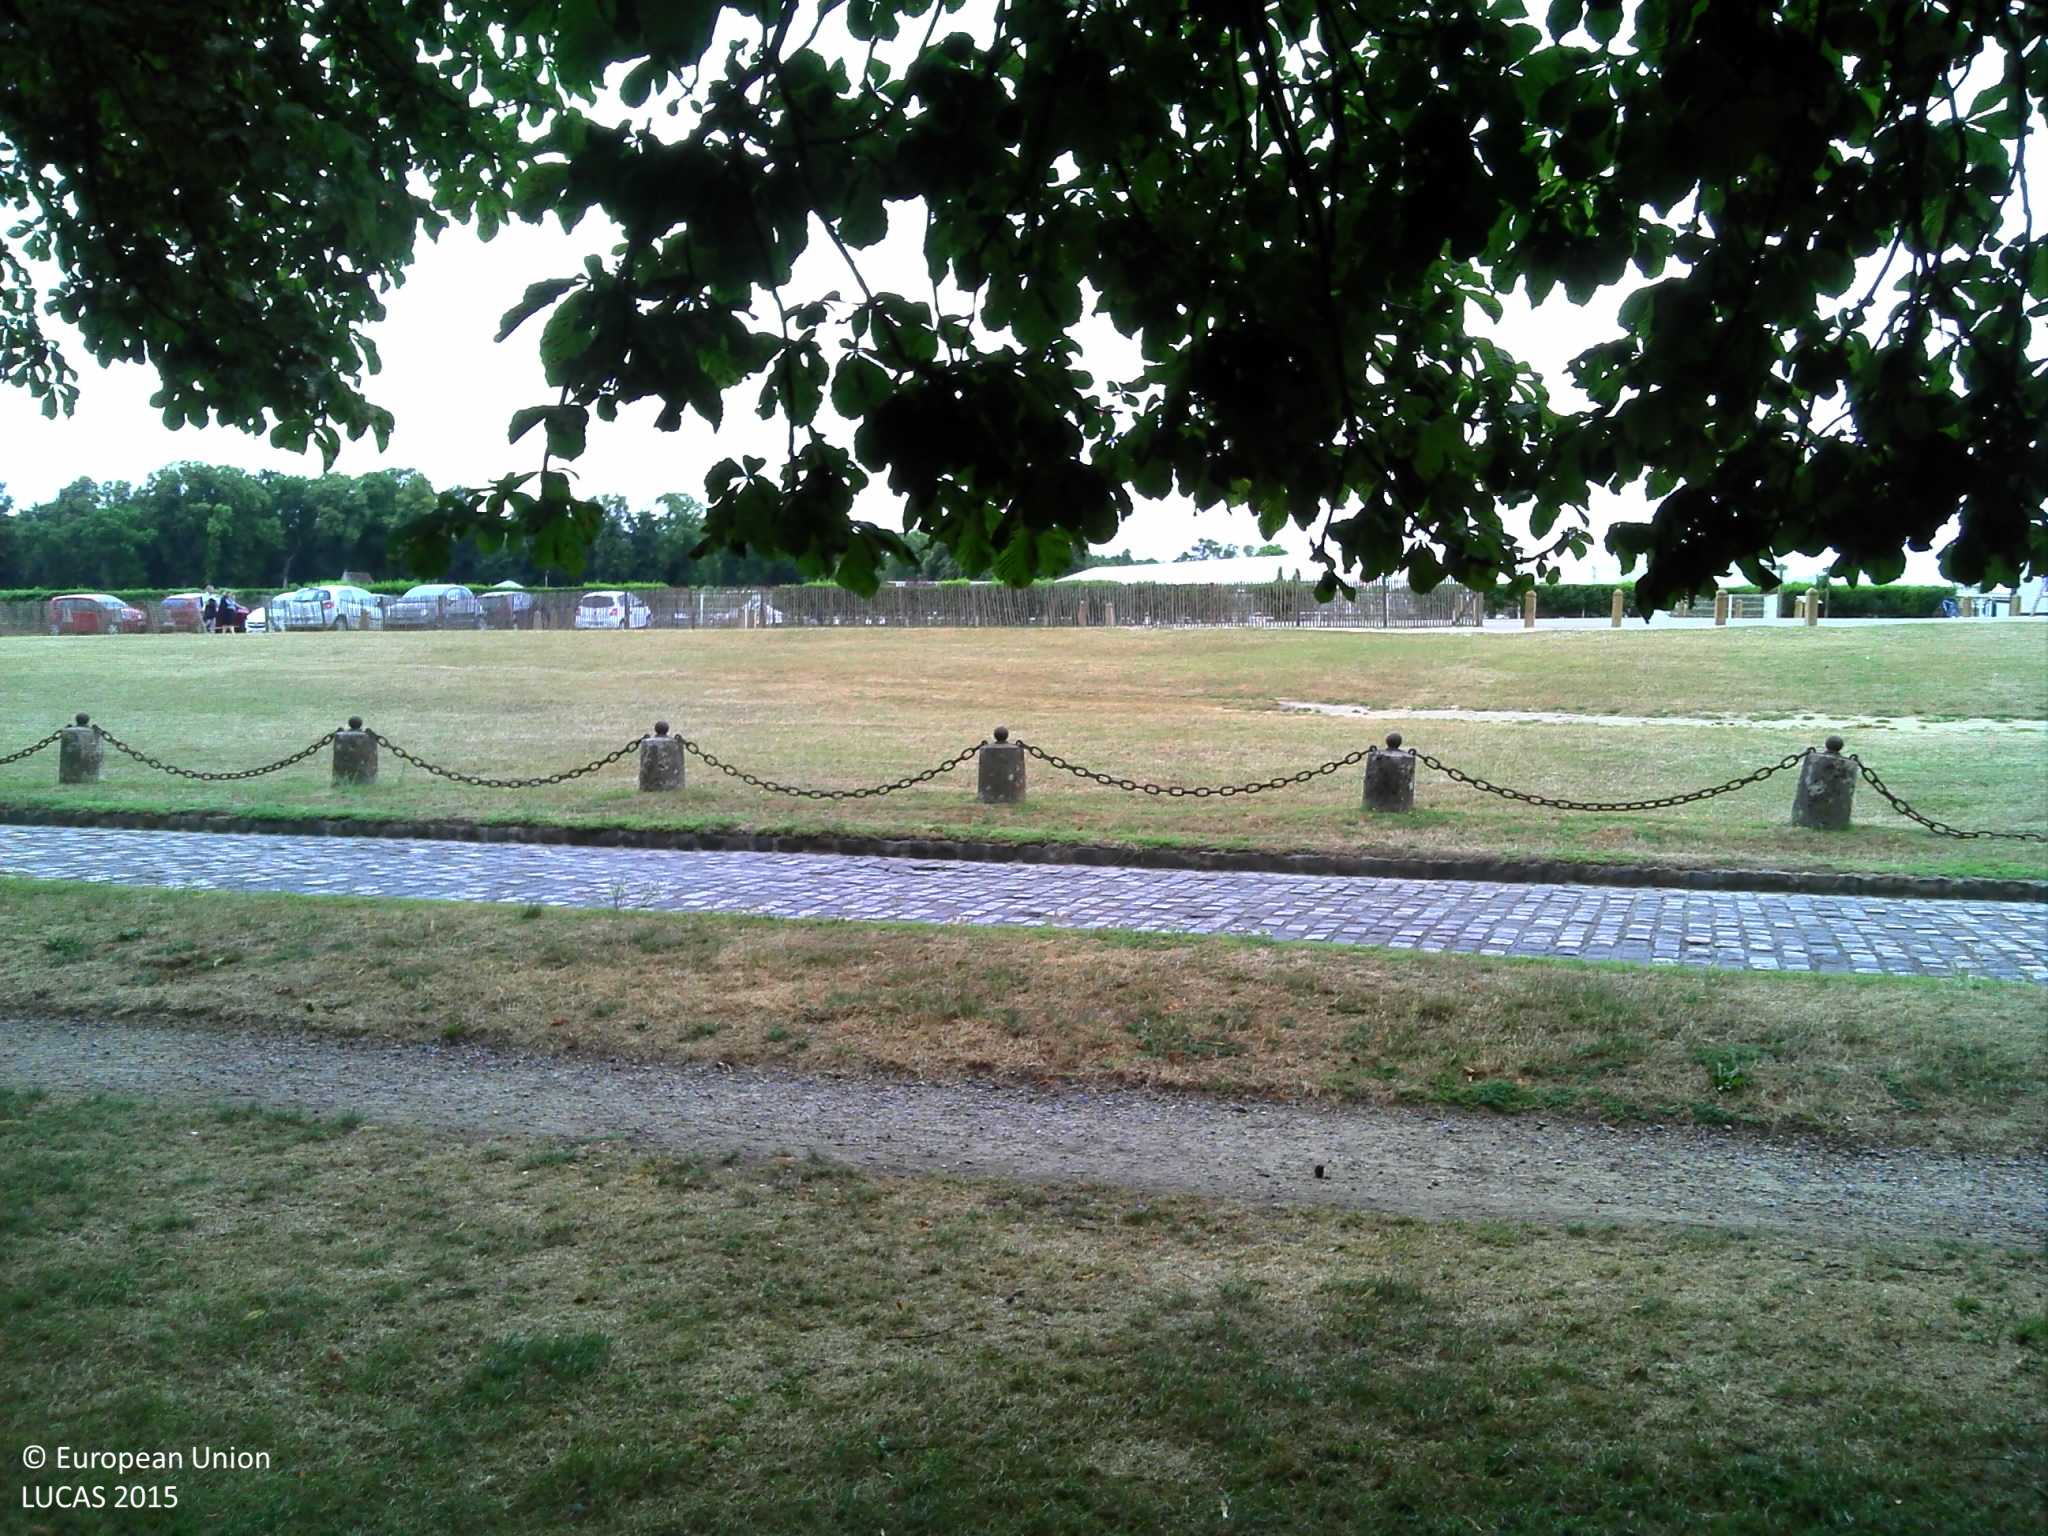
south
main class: Grassland
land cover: Grassland without tree/shrub cover
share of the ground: > 75 %
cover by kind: herbaceous plants 100 %
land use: Amenities, museums, leisure
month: July
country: FR
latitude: 49.1953
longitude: 2.4819
